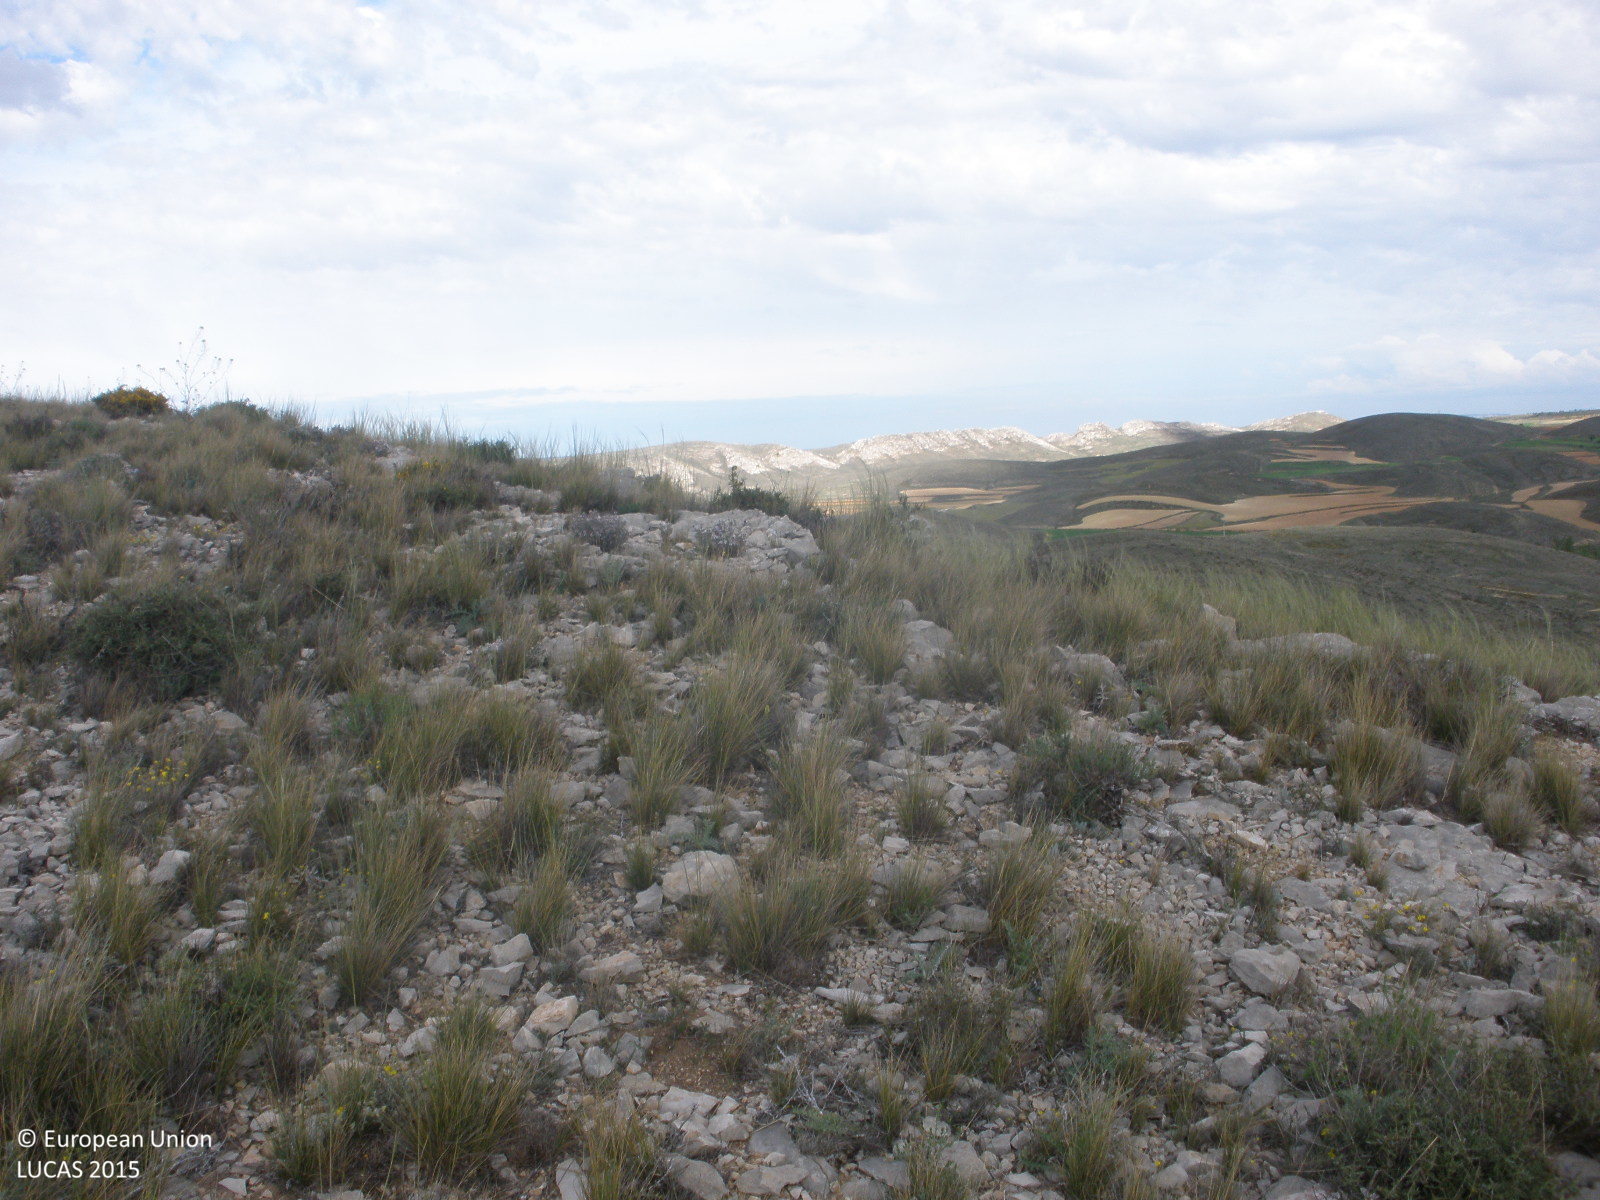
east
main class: Shrubland
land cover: Shrubland without tree cover
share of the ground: 25 - 50 %
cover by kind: herbaceous plants 40 %, shrubs 30 %, consolidated bare surface 30 %
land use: Agriculture (excluding fallow land and kitchen gardens)
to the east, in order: Shrubland without tree cover
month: May
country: ES
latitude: 41.0438
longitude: -0.9014
